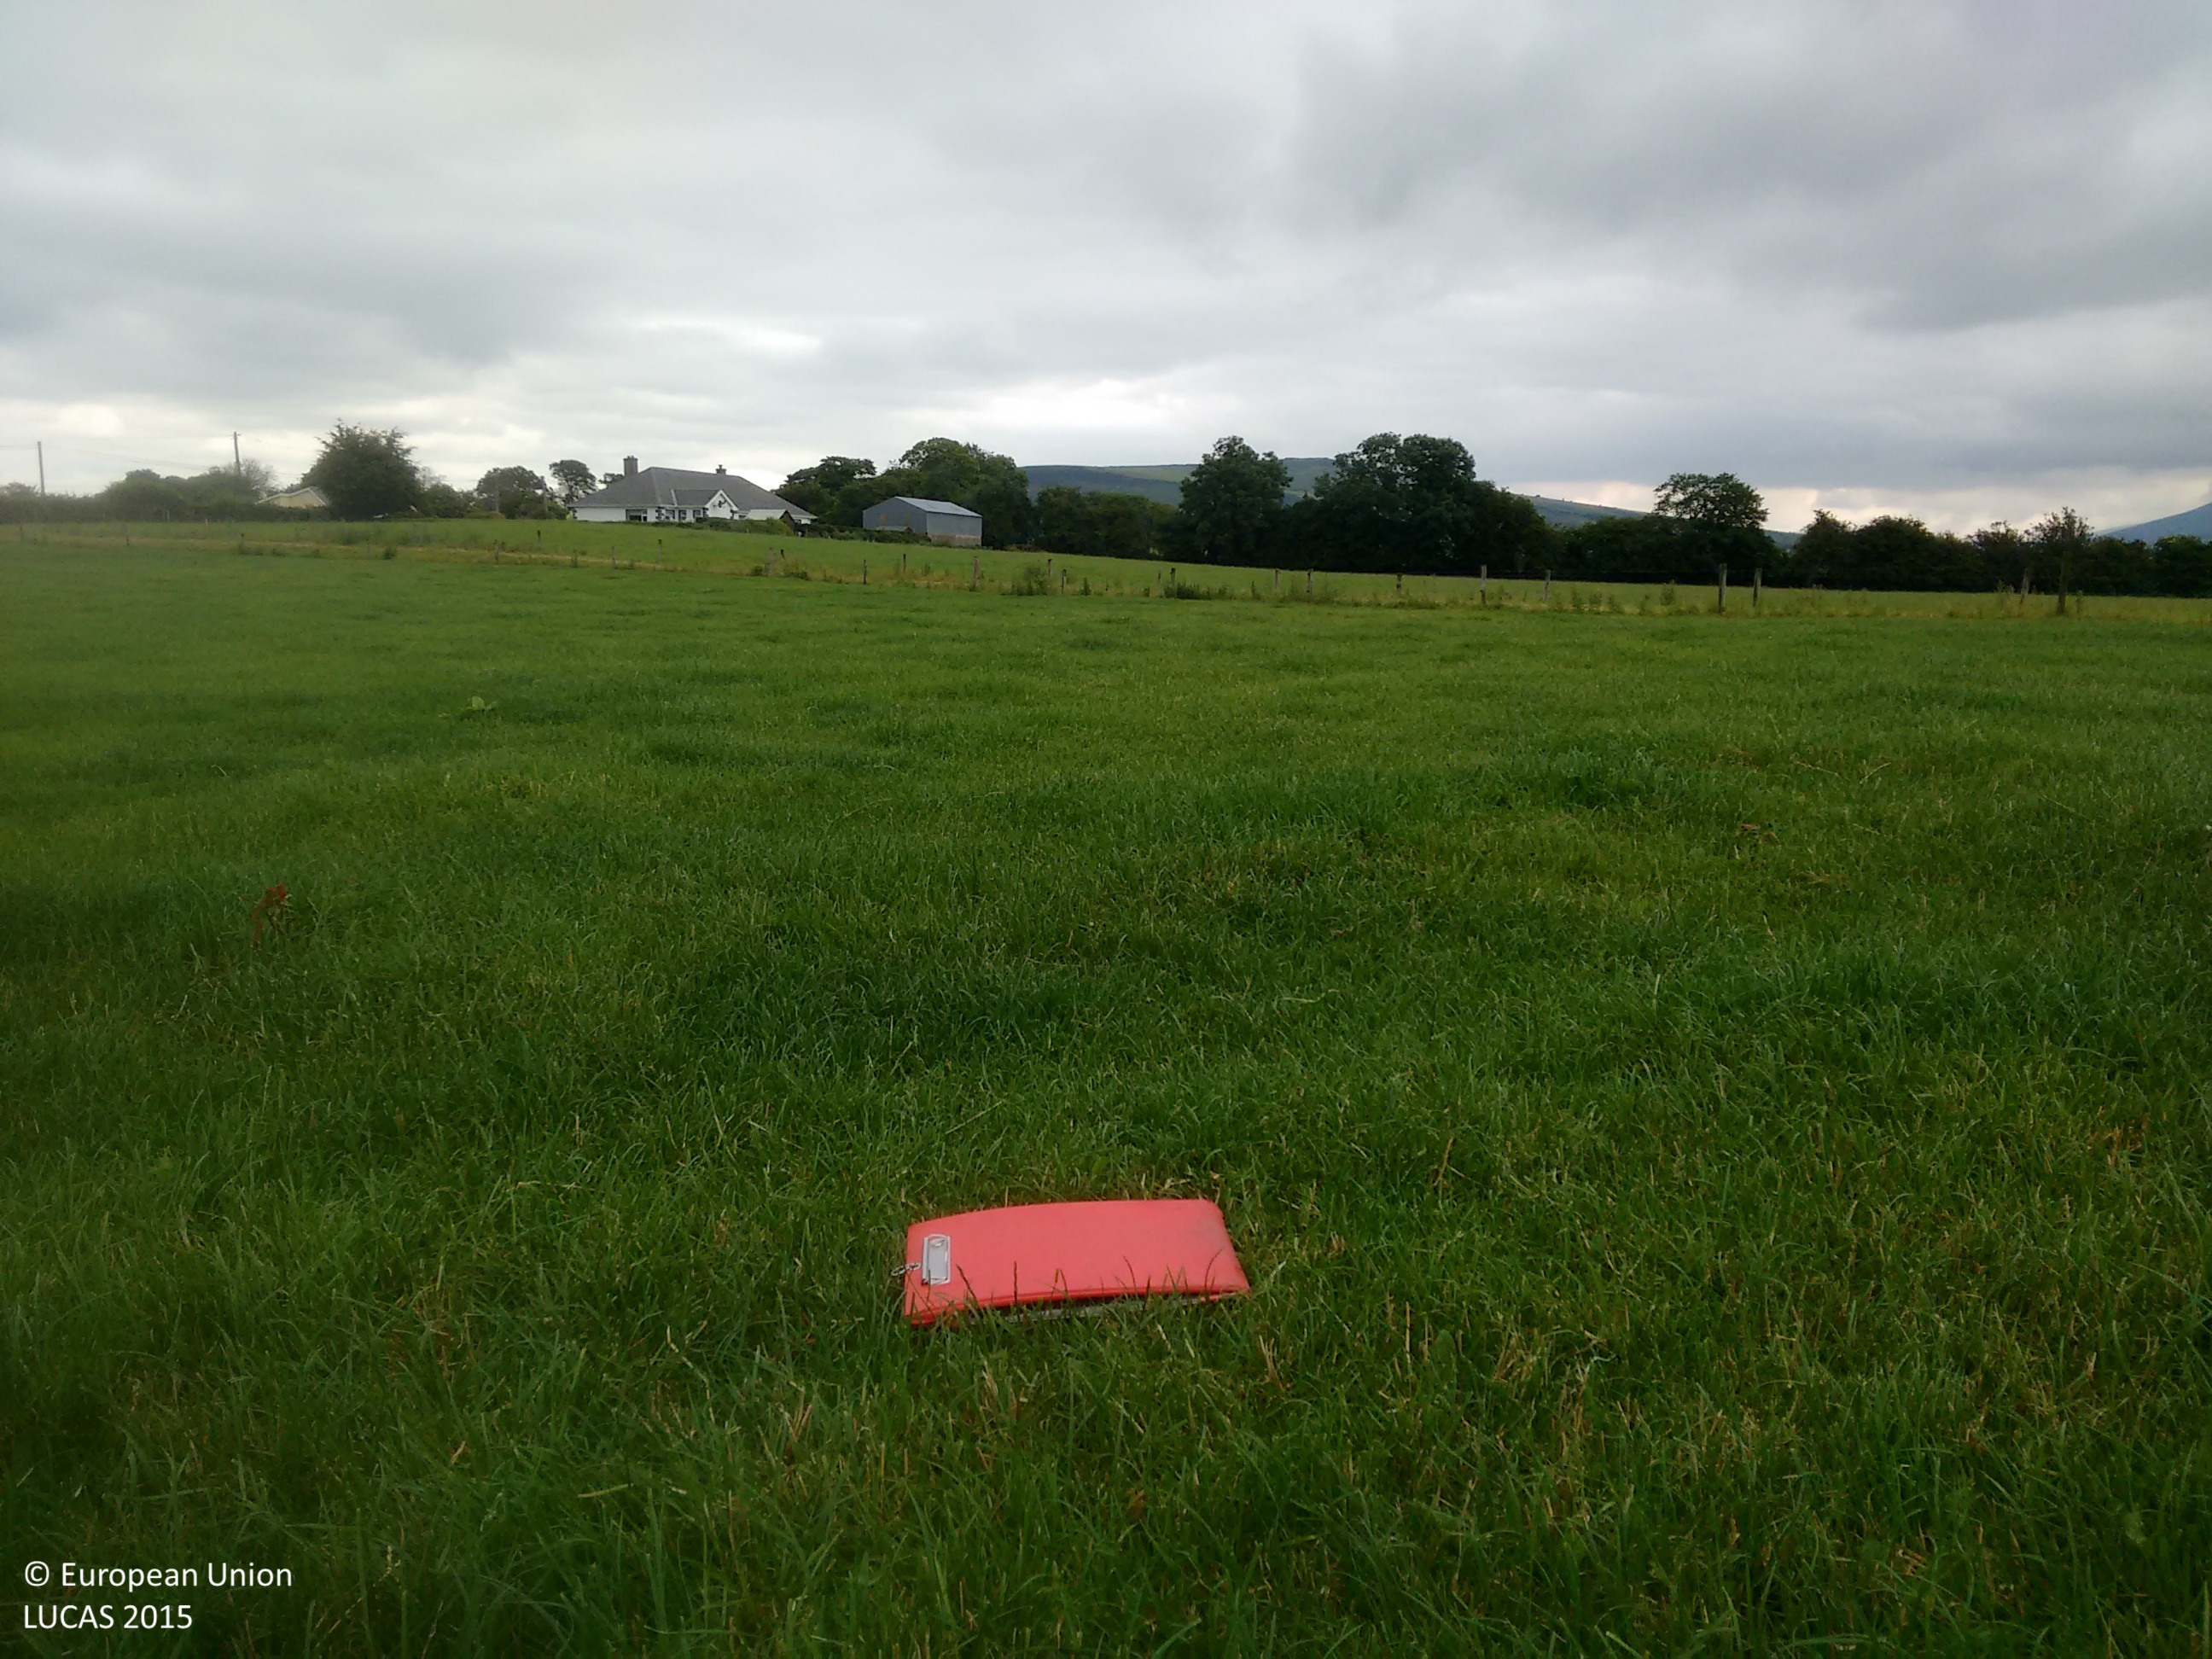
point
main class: Grassland
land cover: Grassland without tree/shrub cover
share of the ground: > 75 %
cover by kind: herbaceous plants 100 %
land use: Agriculture (excluding fallow land and kitchen gardens)
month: July
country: IE
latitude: 52.9260
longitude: -6.7197
